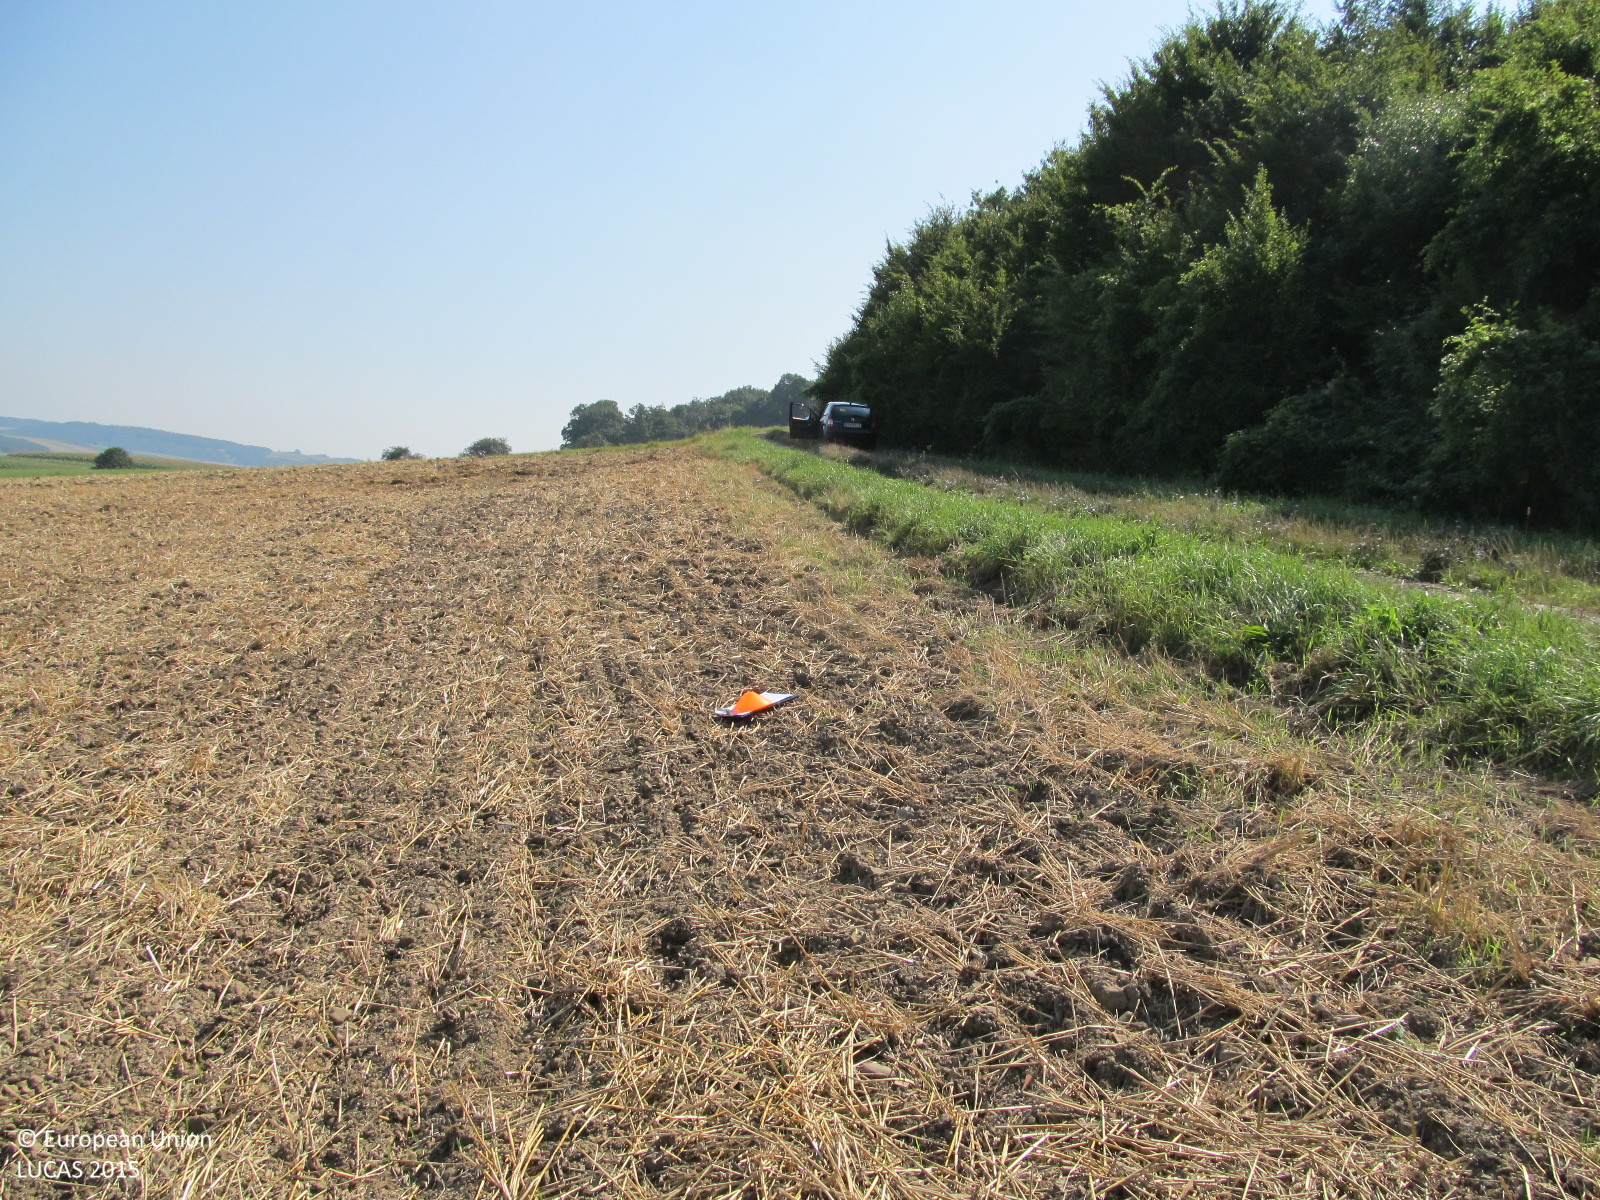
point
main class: Cropland
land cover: Common wheat
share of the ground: 10 - 25 %
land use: Agriculture (excluding fallow land and kitchen gardens)
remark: Harvested field
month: August
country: AT
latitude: 48.1805
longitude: 15.7728
